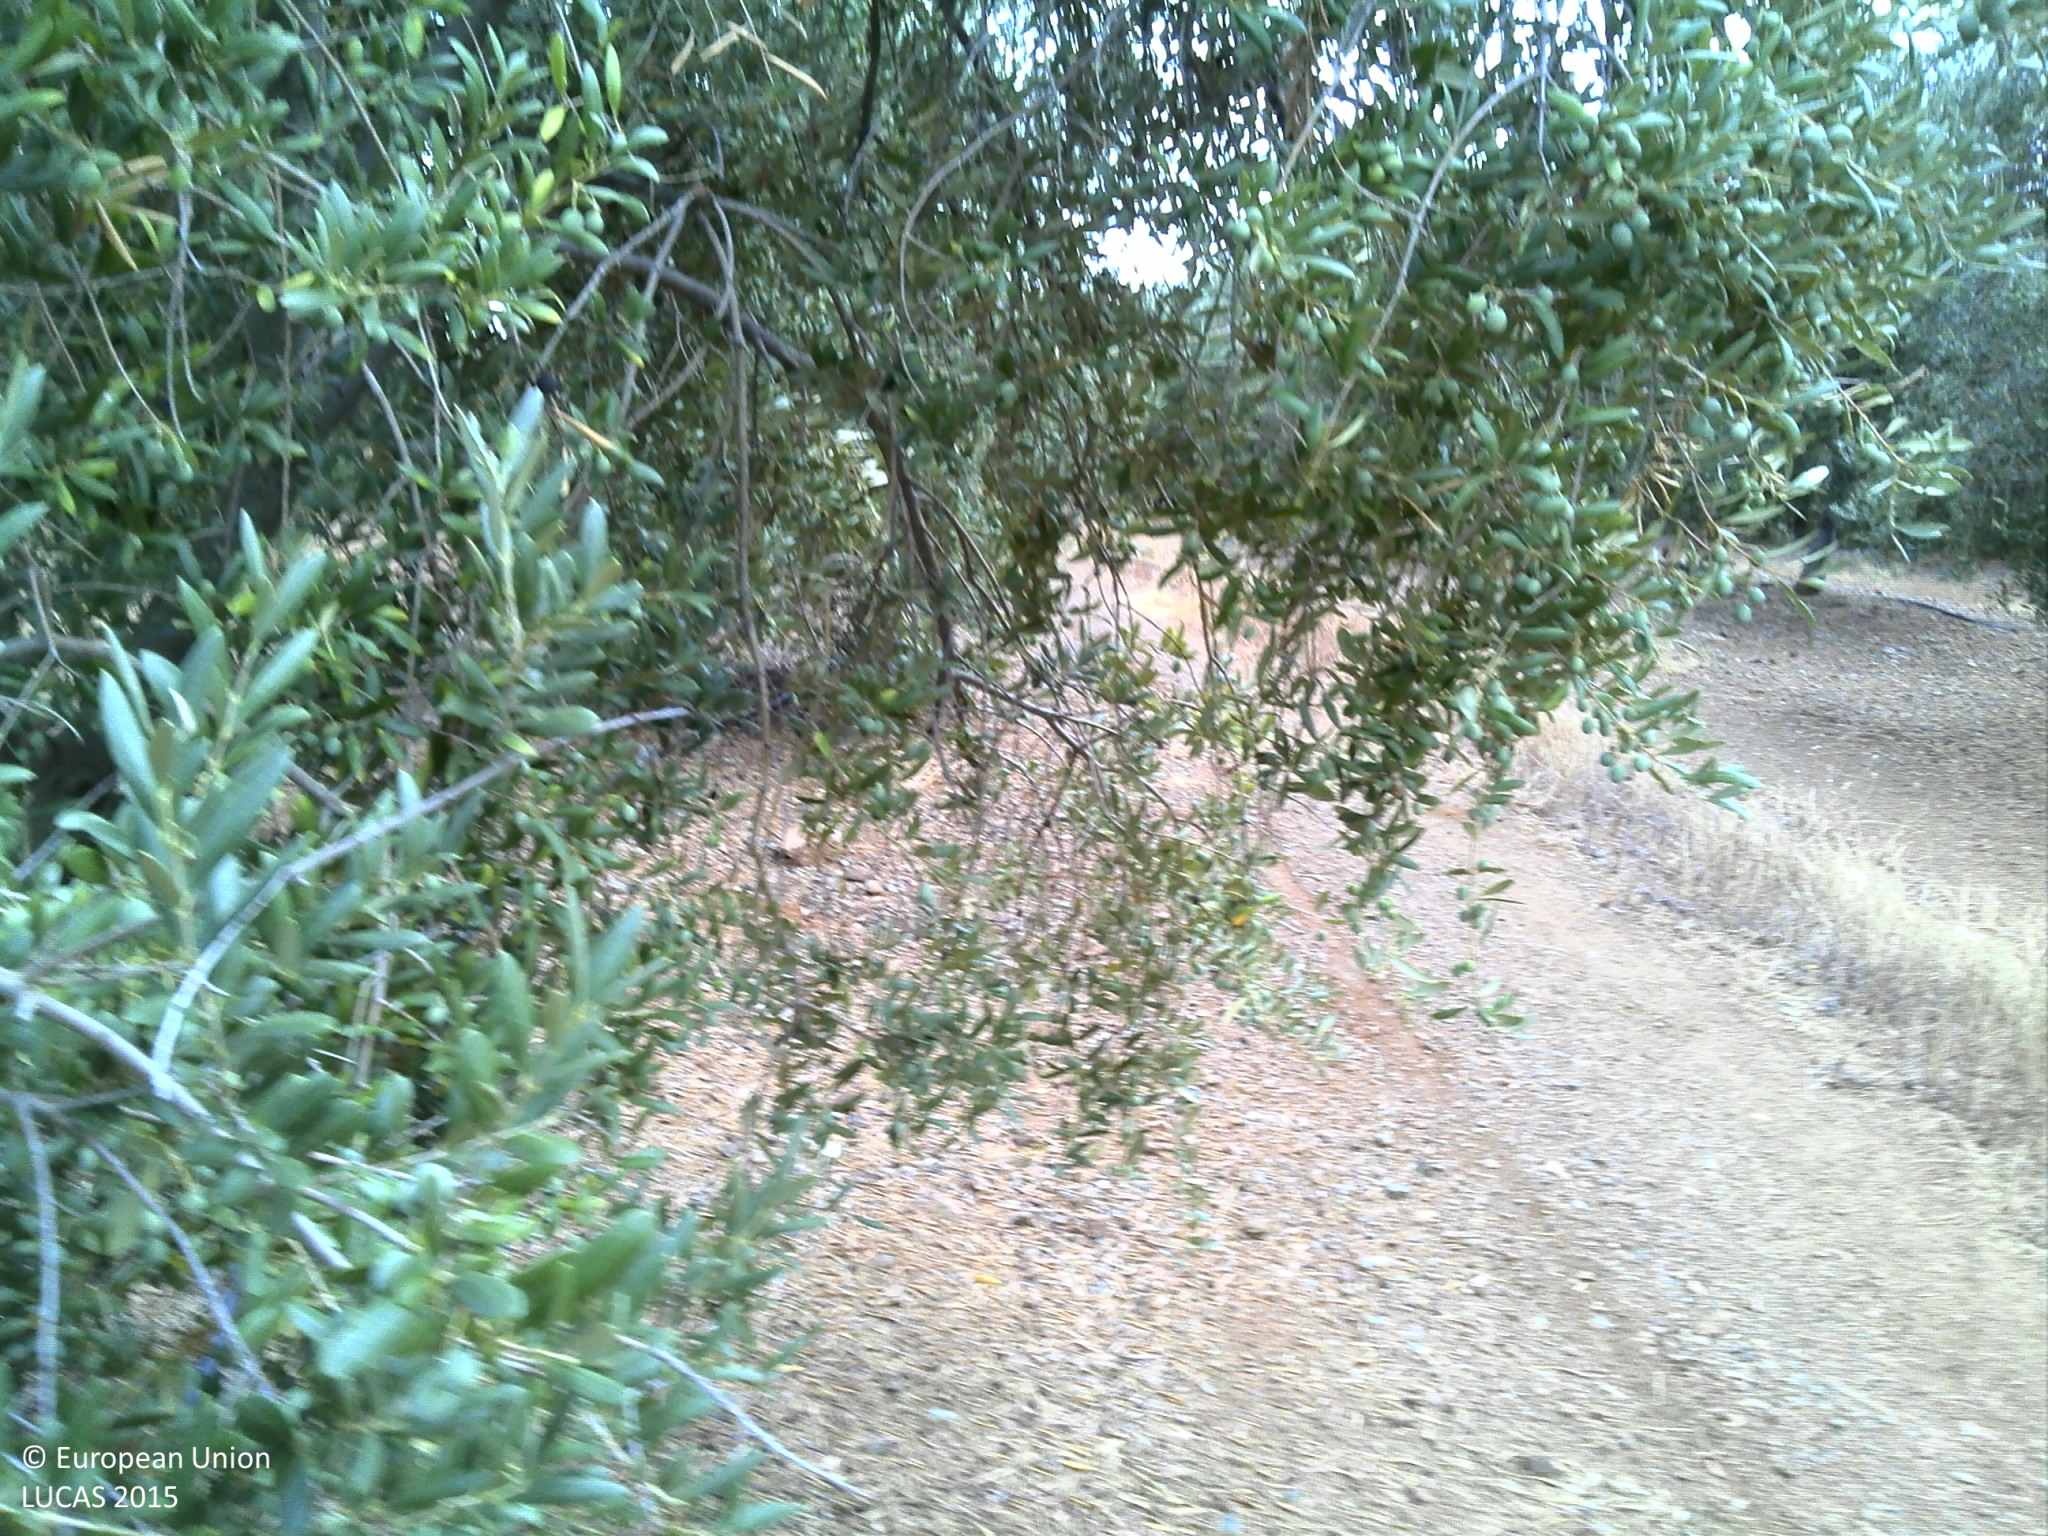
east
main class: Cropland
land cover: Olive groves
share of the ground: 50 - 75 %
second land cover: Grassland without tree/shrub cover
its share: < 10 %
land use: Agriculture (excluding fallow land and kitchen gardens)
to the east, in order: Olive groves; Grassland without tree/shrub cover; Olive groves; Tracks; Grass margins; Fences; Grassland without tree/shrub cover
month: July
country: PT
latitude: 38.0697
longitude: -7.7046
